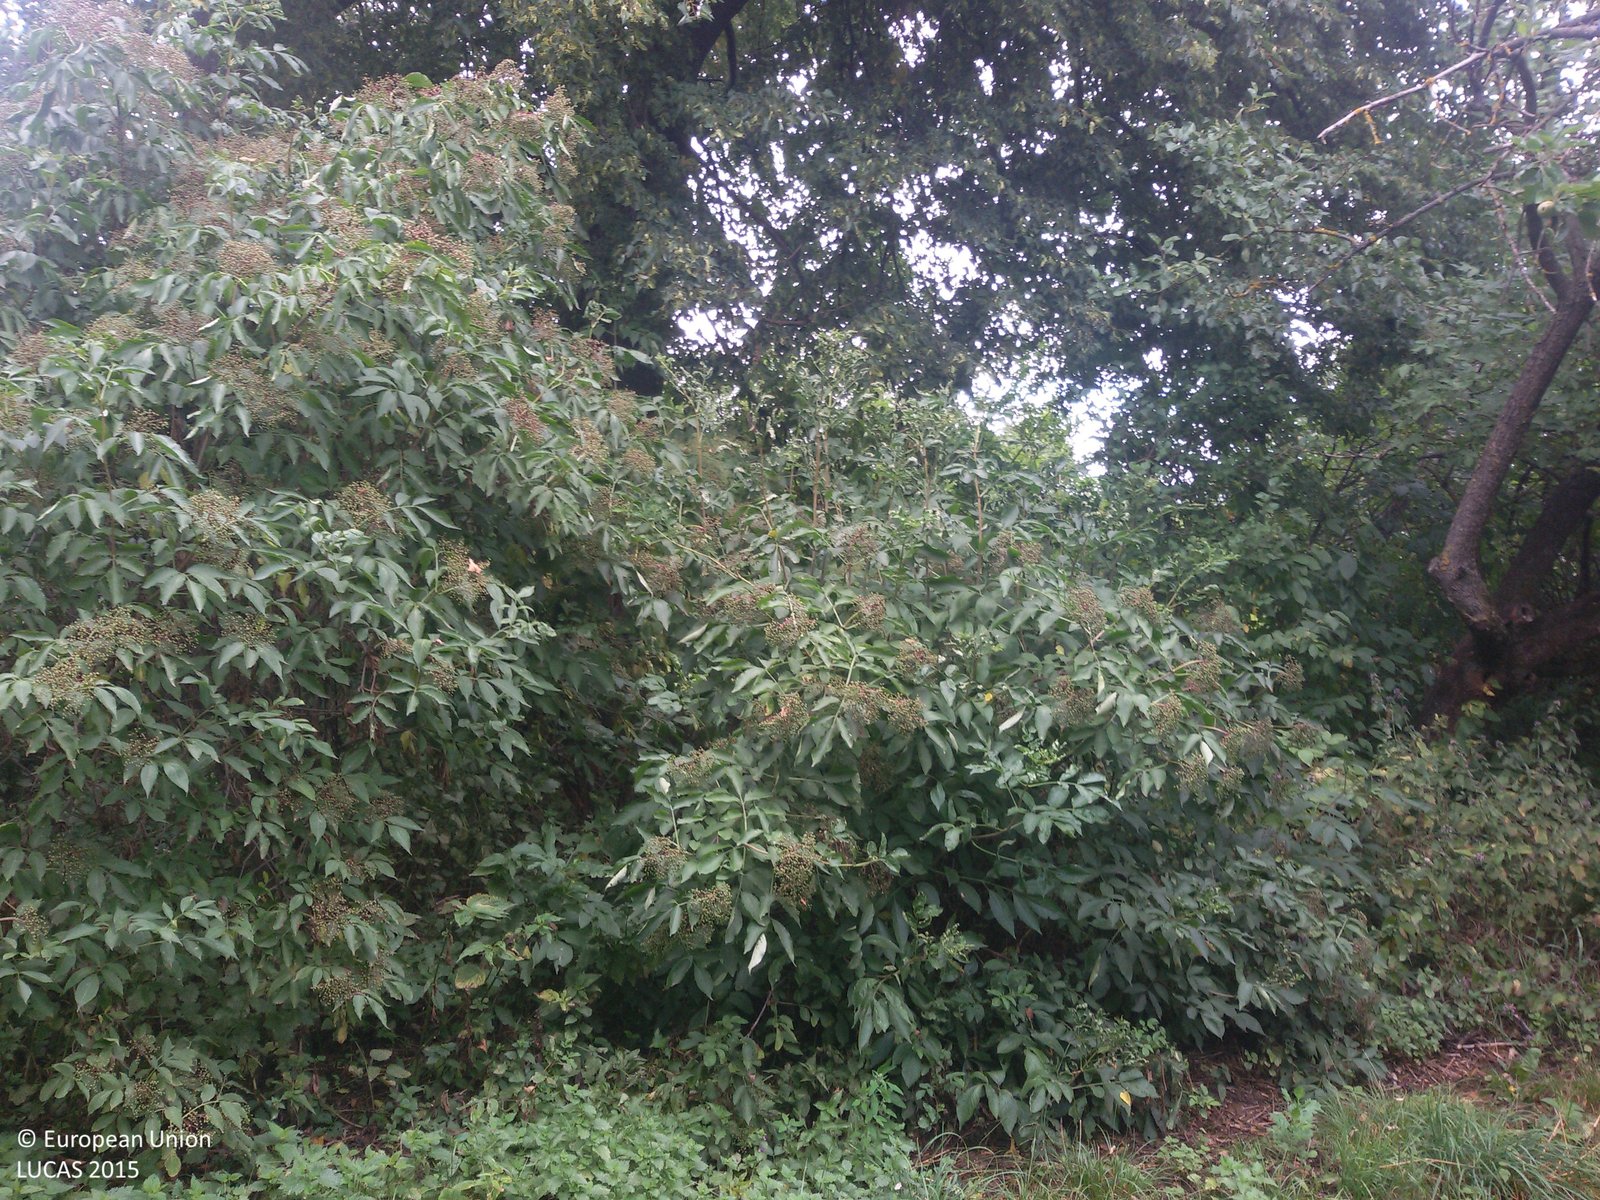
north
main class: Woodland
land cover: Broadleaved woodland
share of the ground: 50 - 75 %
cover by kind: shrubs 65 %, broadleaved forest trees 20 %, herbaceous plants 5 %
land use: Residential
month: July
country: PL
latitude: 53.6732
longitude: 23.5721
